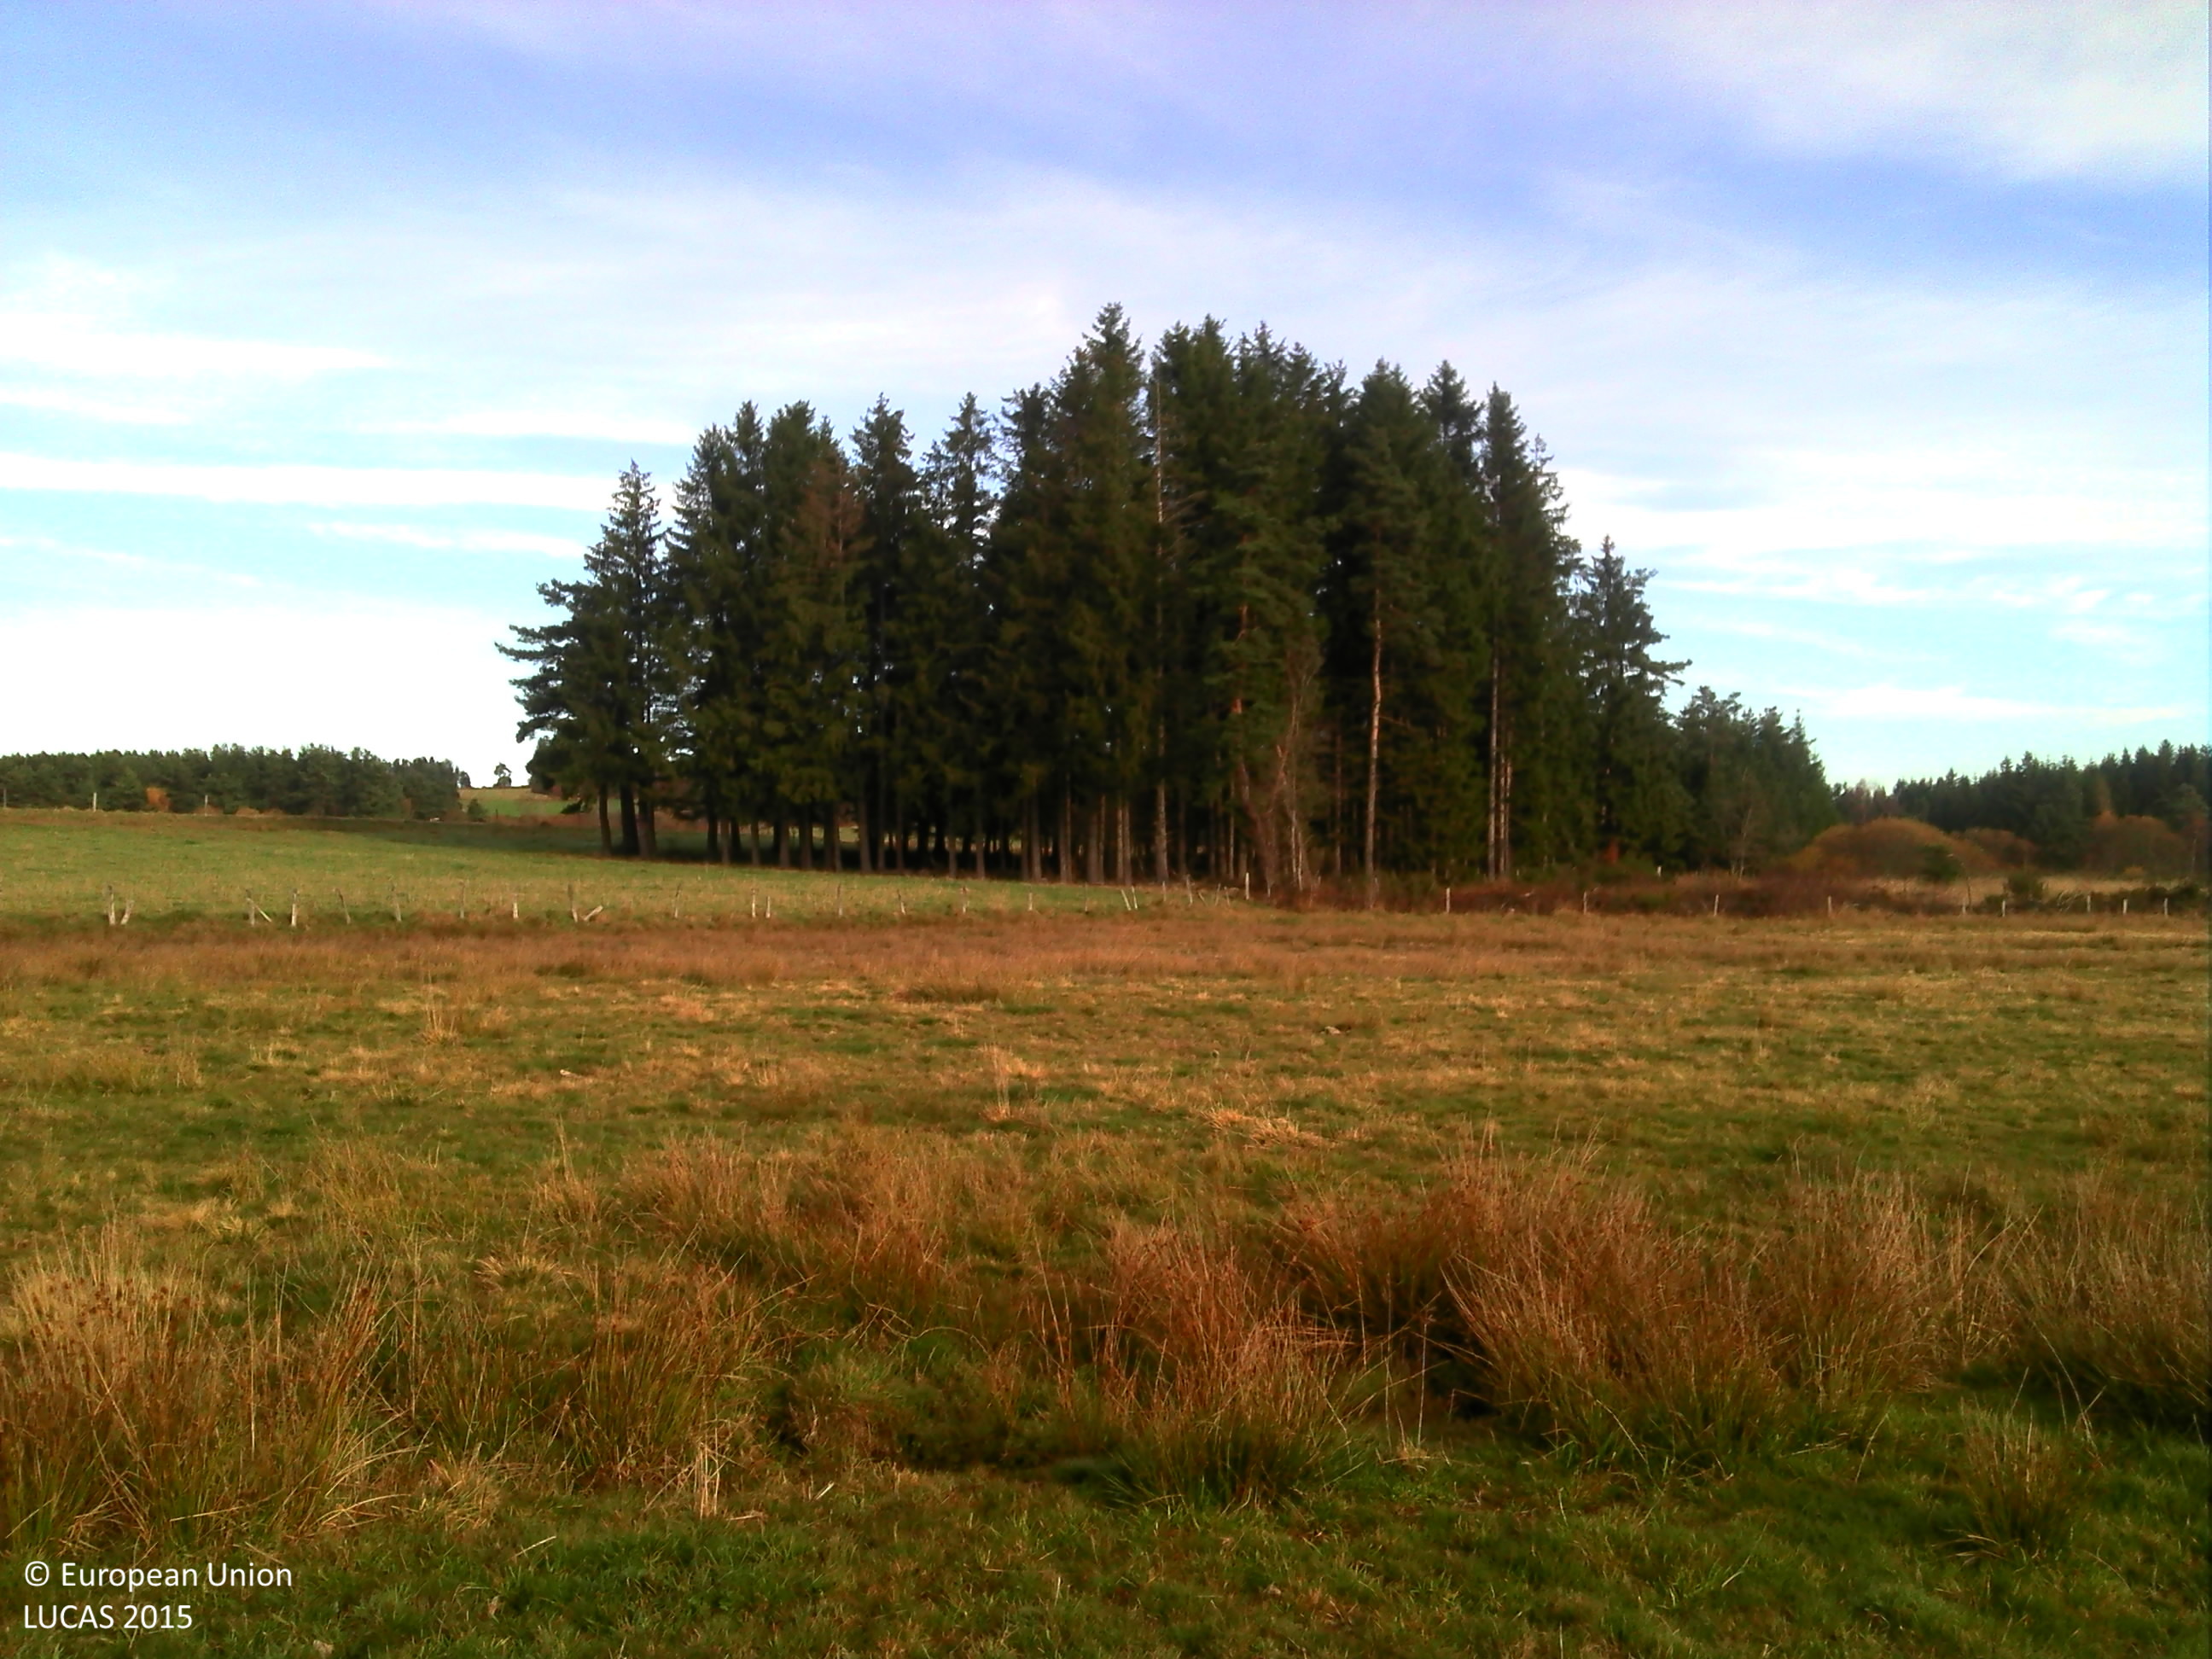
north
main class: Grassland
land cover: Grassland without tree/shrub cover
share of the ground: > 75 %
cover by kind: herbaceous plants 100 %
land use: Agriculture (excluding fallow land and kitchen gardens)
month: November
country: FR
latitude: 45.3216
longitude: 3.7902
